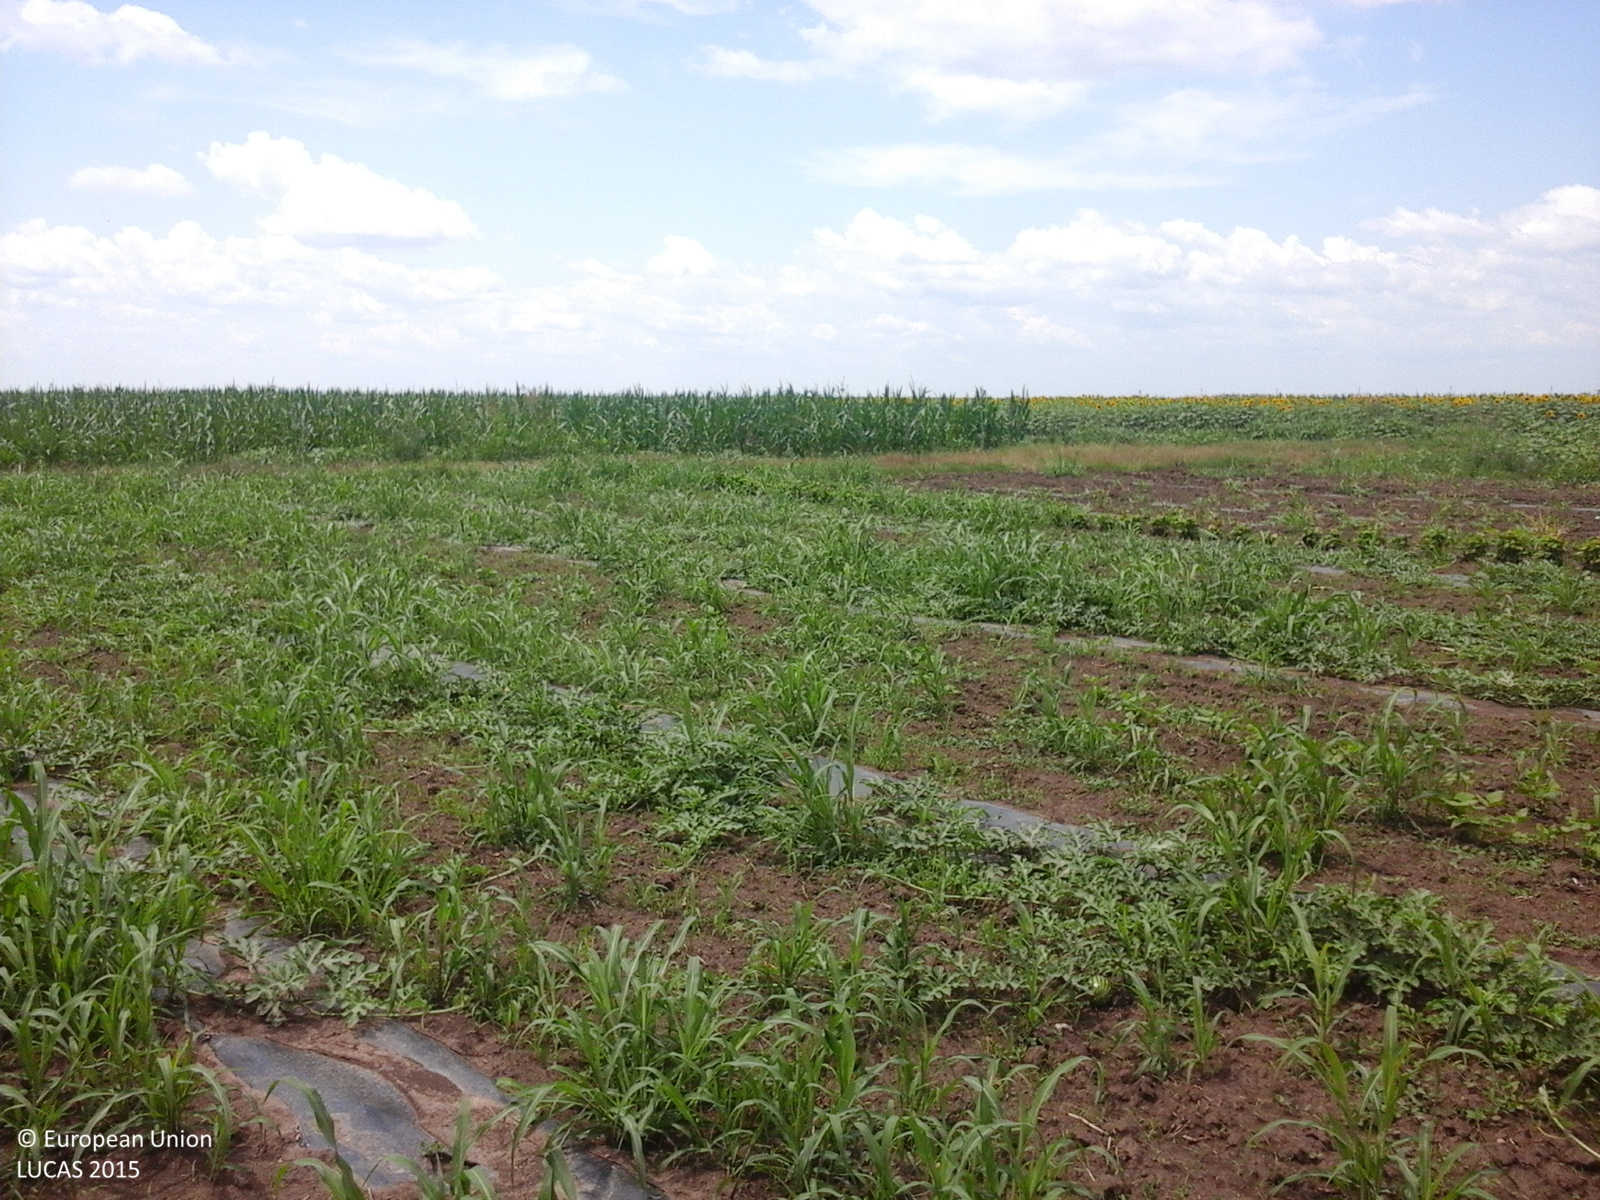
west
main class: Cropland
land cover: Other fresh vegetables
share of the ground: 50 - 75 %
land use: Agriculture (excluding fallow land and kitchen gardens)
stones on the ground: < 10 %
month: July
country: RO
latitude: 44.0530
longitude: 24.5343
